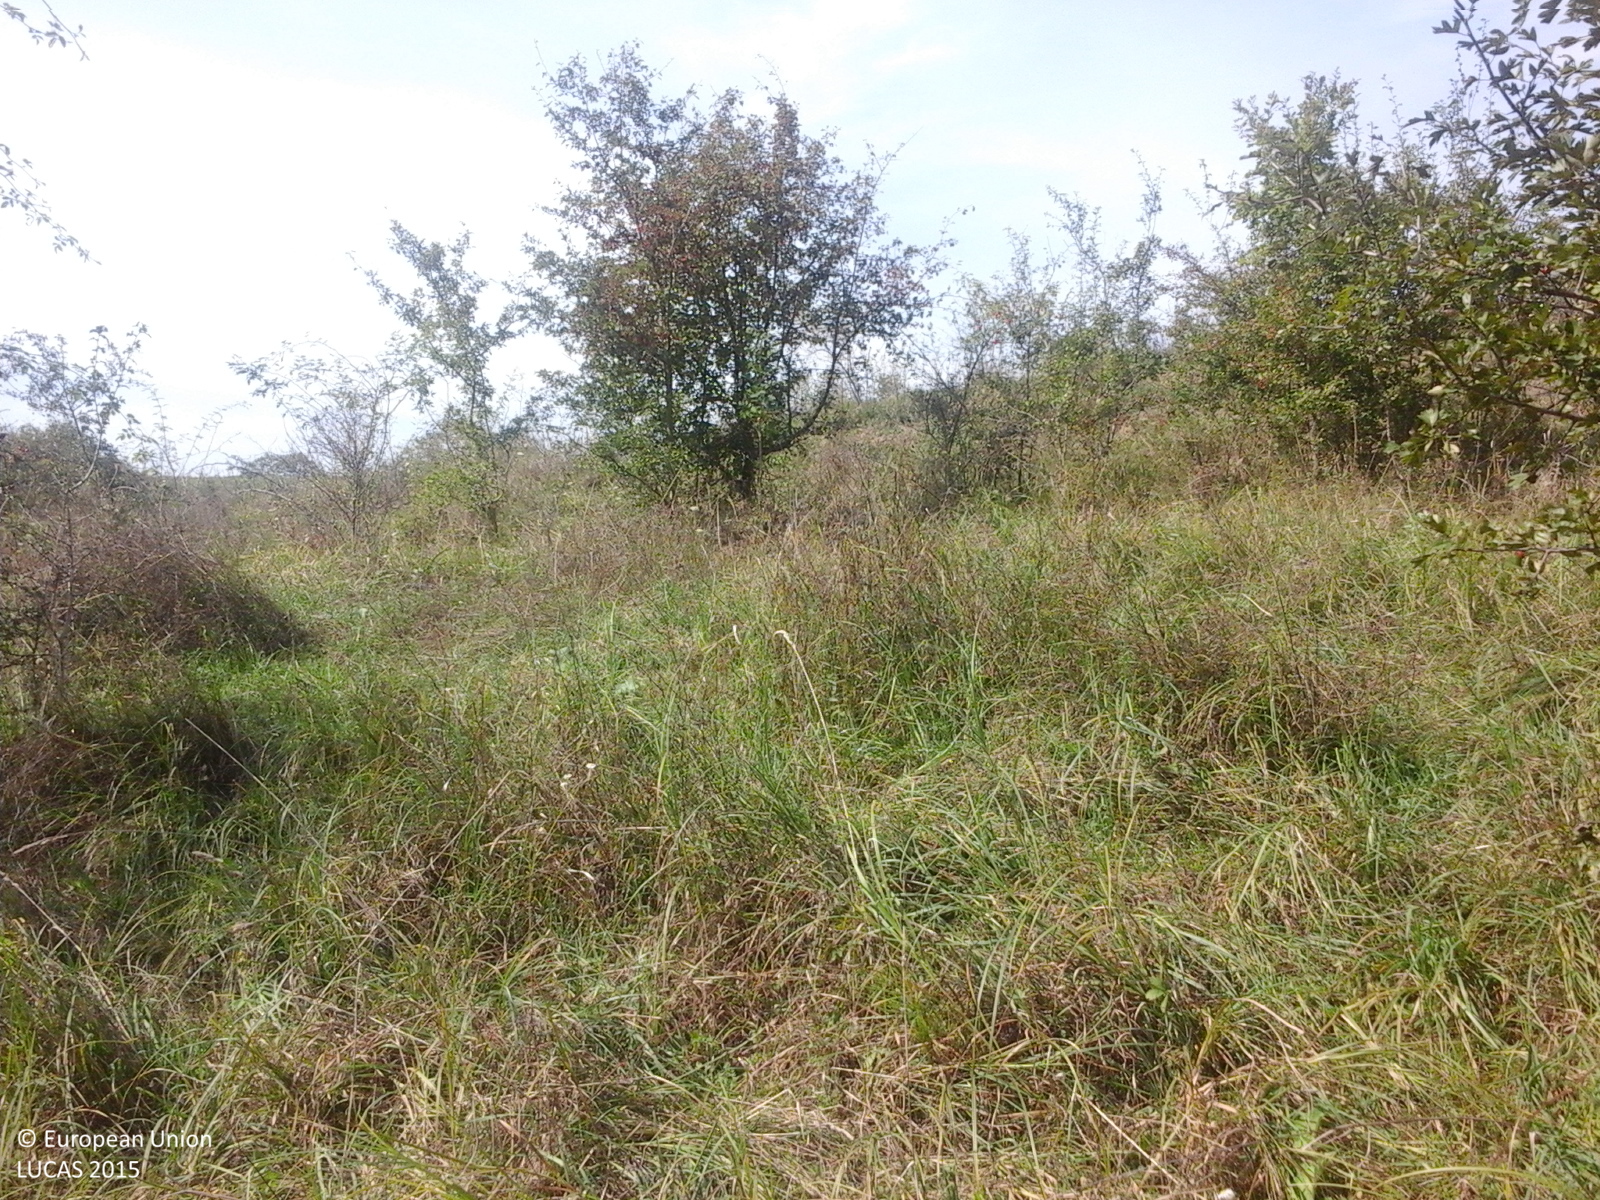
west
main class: Grassland
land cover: Grassland with sparse tree/shrub cover
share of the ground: > 75 %
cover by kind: herbaceous plants 95 %, broadleaved forest trees 5 %
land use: Fallow land
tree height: < 5 m
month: September
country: RO
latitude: 47.2471
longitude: 23.7514
